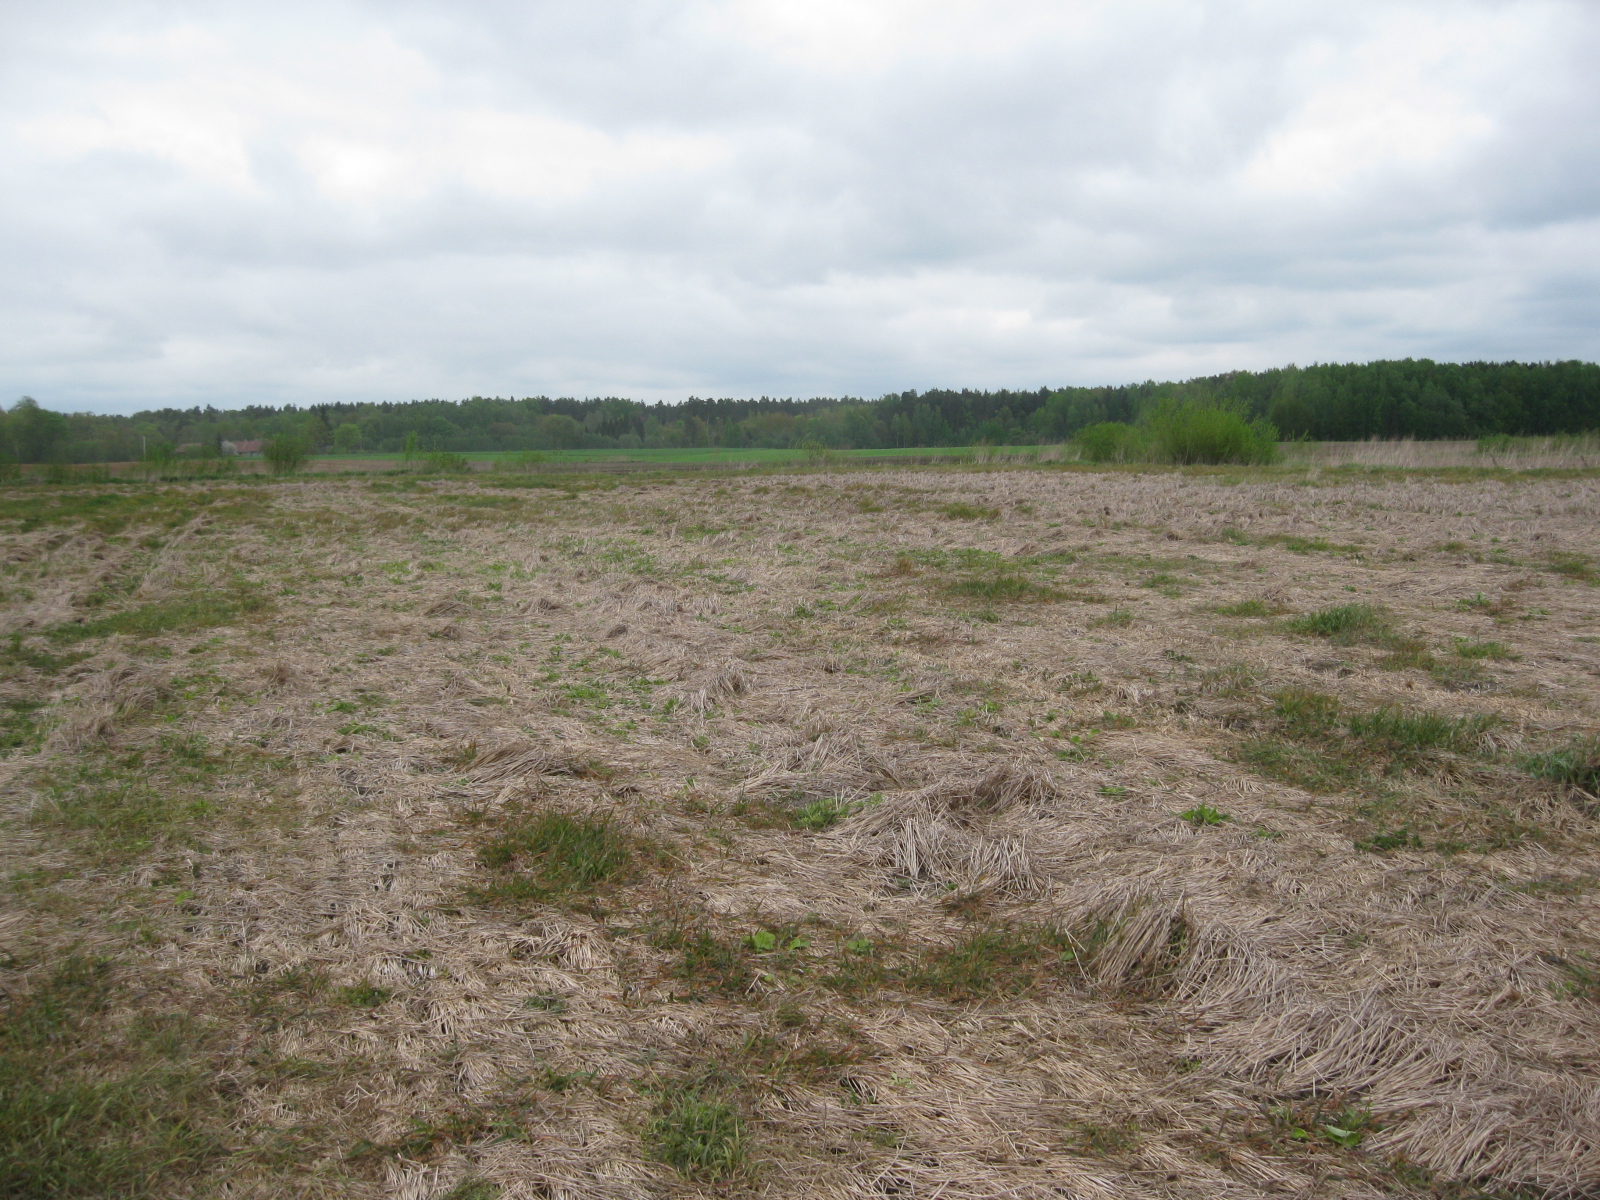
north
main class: Grassland
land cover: Spontaneously vegetated surfaces
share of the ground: 10 - 25 %
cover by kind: unconsolidated bare surface 30 %, herbaceous plants 20 %
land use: Fallow land
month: May
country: LT
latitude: 55.9413
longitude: 24.3606
